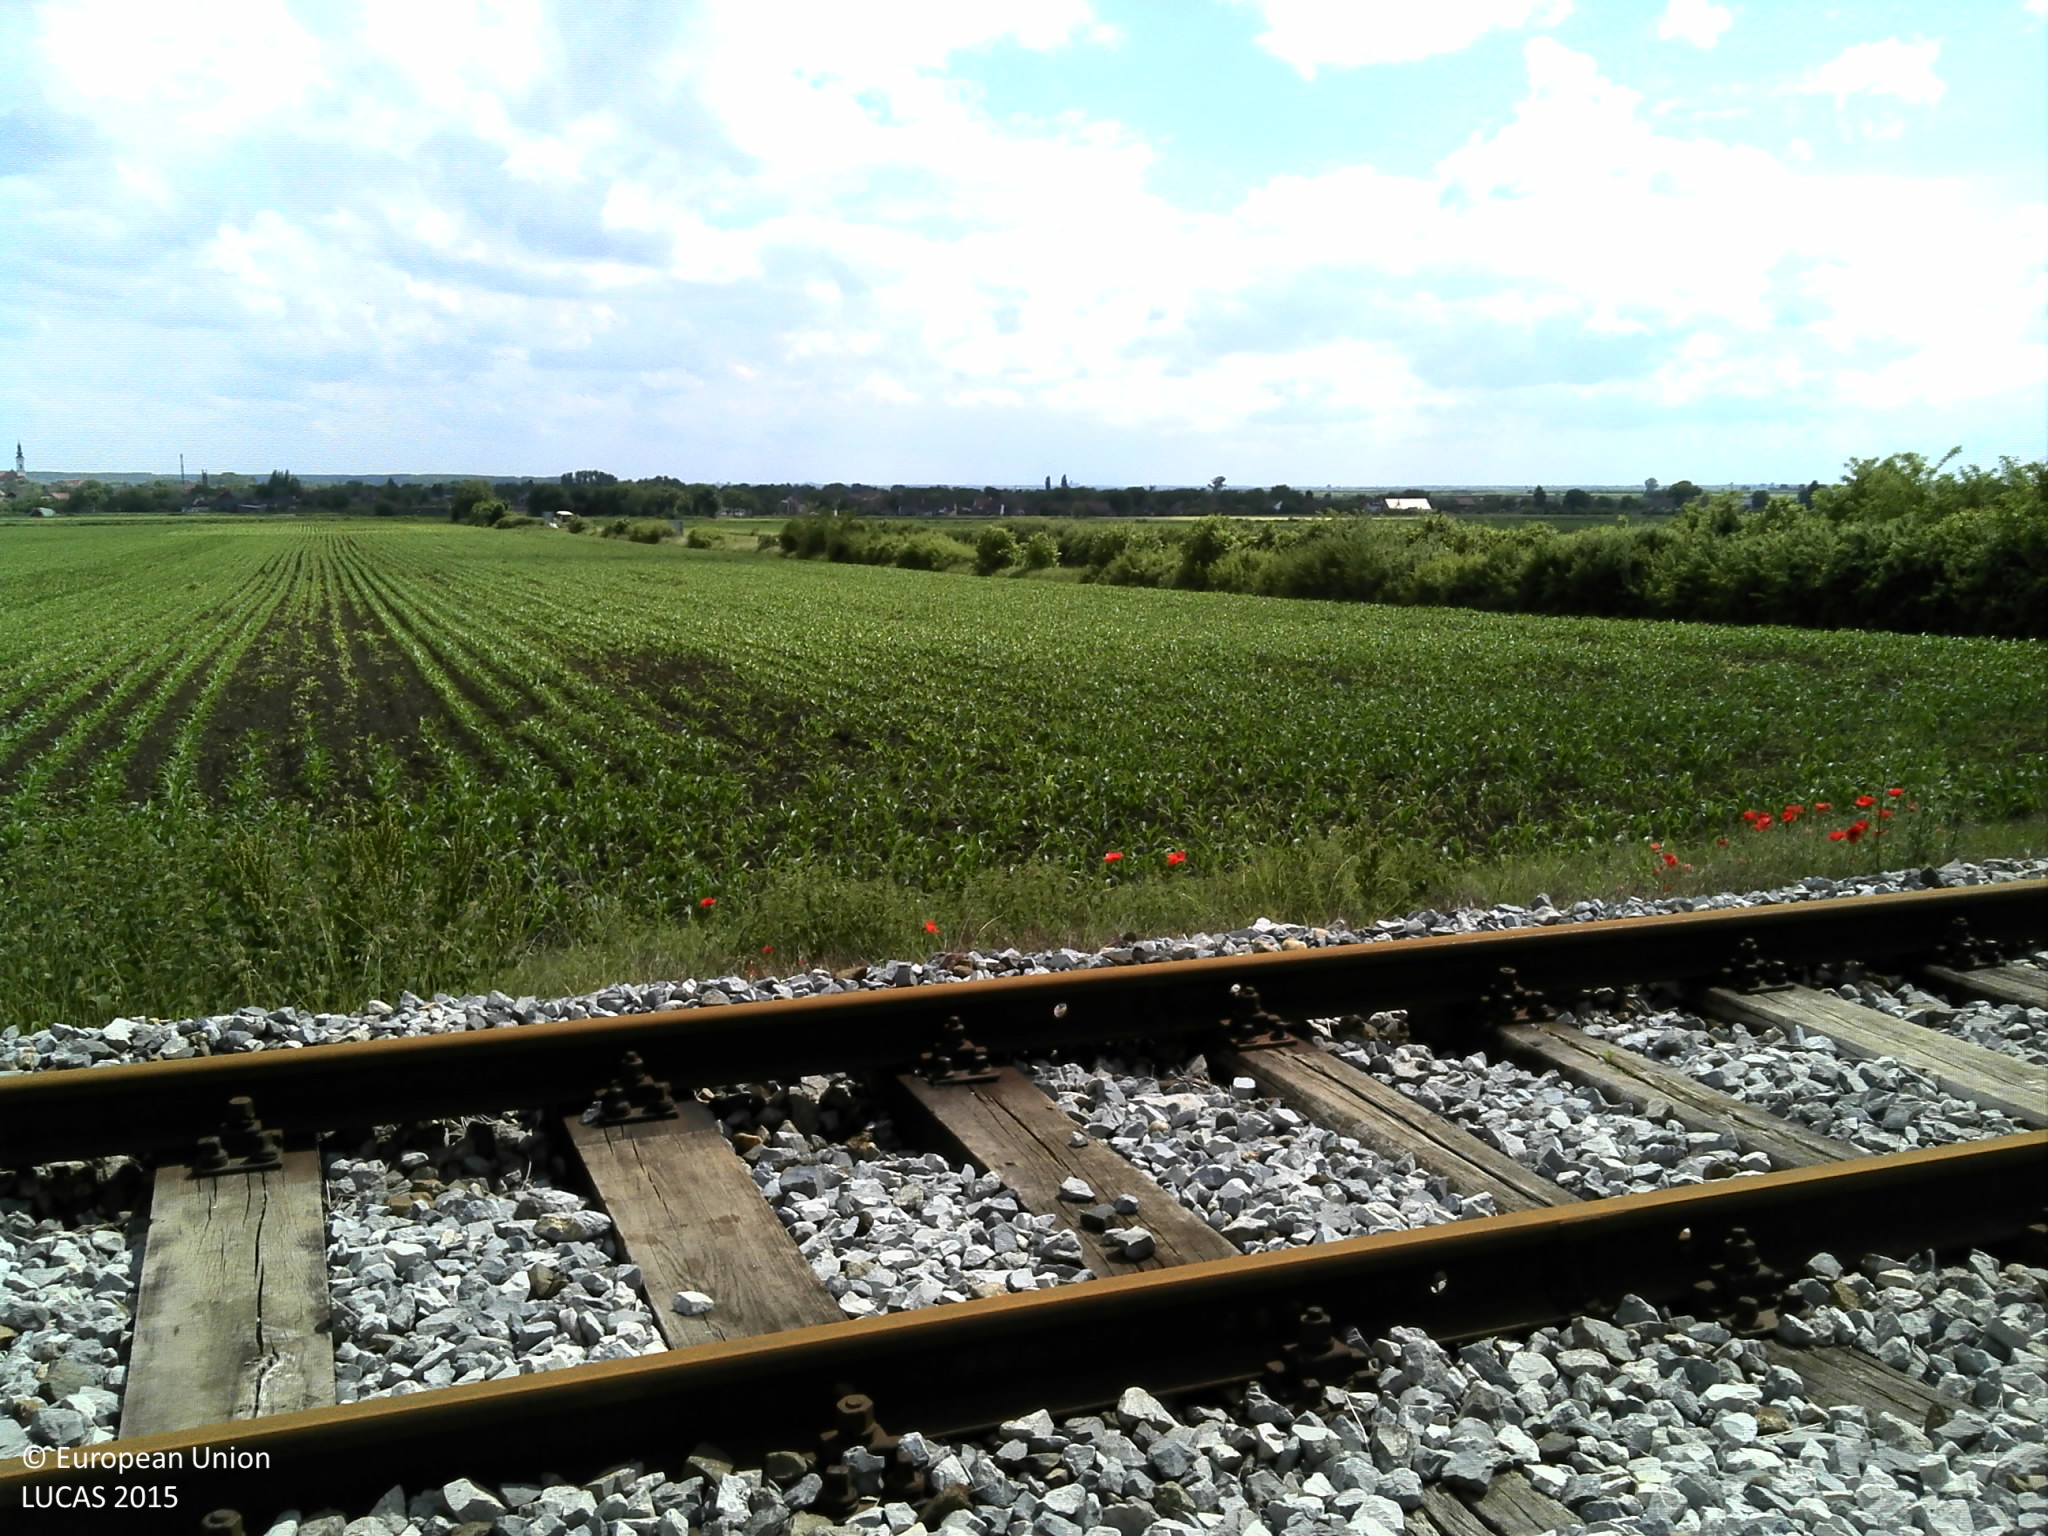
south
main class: Grassland
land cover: Grassland with sparse tree/shrub cover
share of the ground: > 75 %
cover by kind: herbaceous plants 85 %, shrubs 10 %, broadleaved forest trees 5 %
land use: Railway transport
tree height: < 5 m
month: May
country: HR
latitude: 45.5016
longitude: 18.9807
